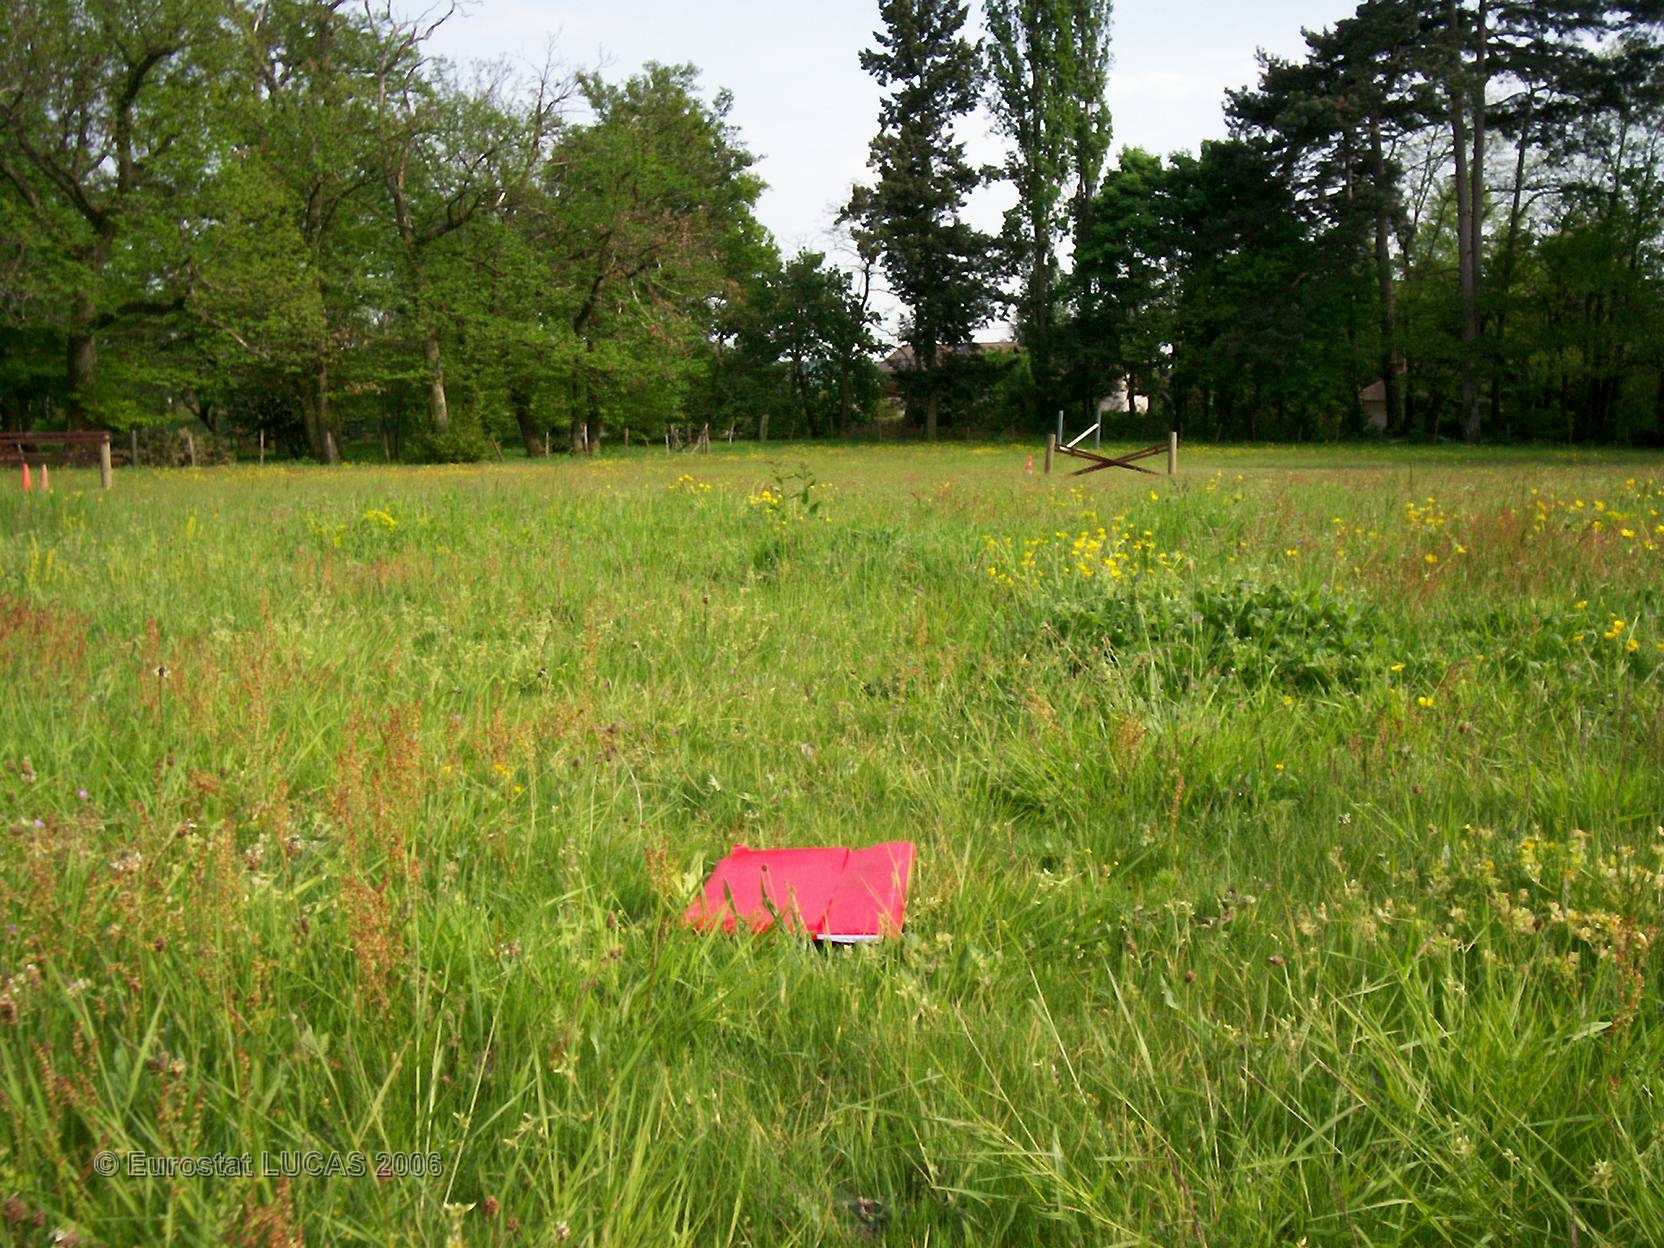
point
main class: Grassland
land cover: Grassland without tree/shrub cover
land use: Agriculture (excluding fallow land and kitchen gardens)
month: May
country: FR
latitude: 45.9362
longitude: 4.8054
